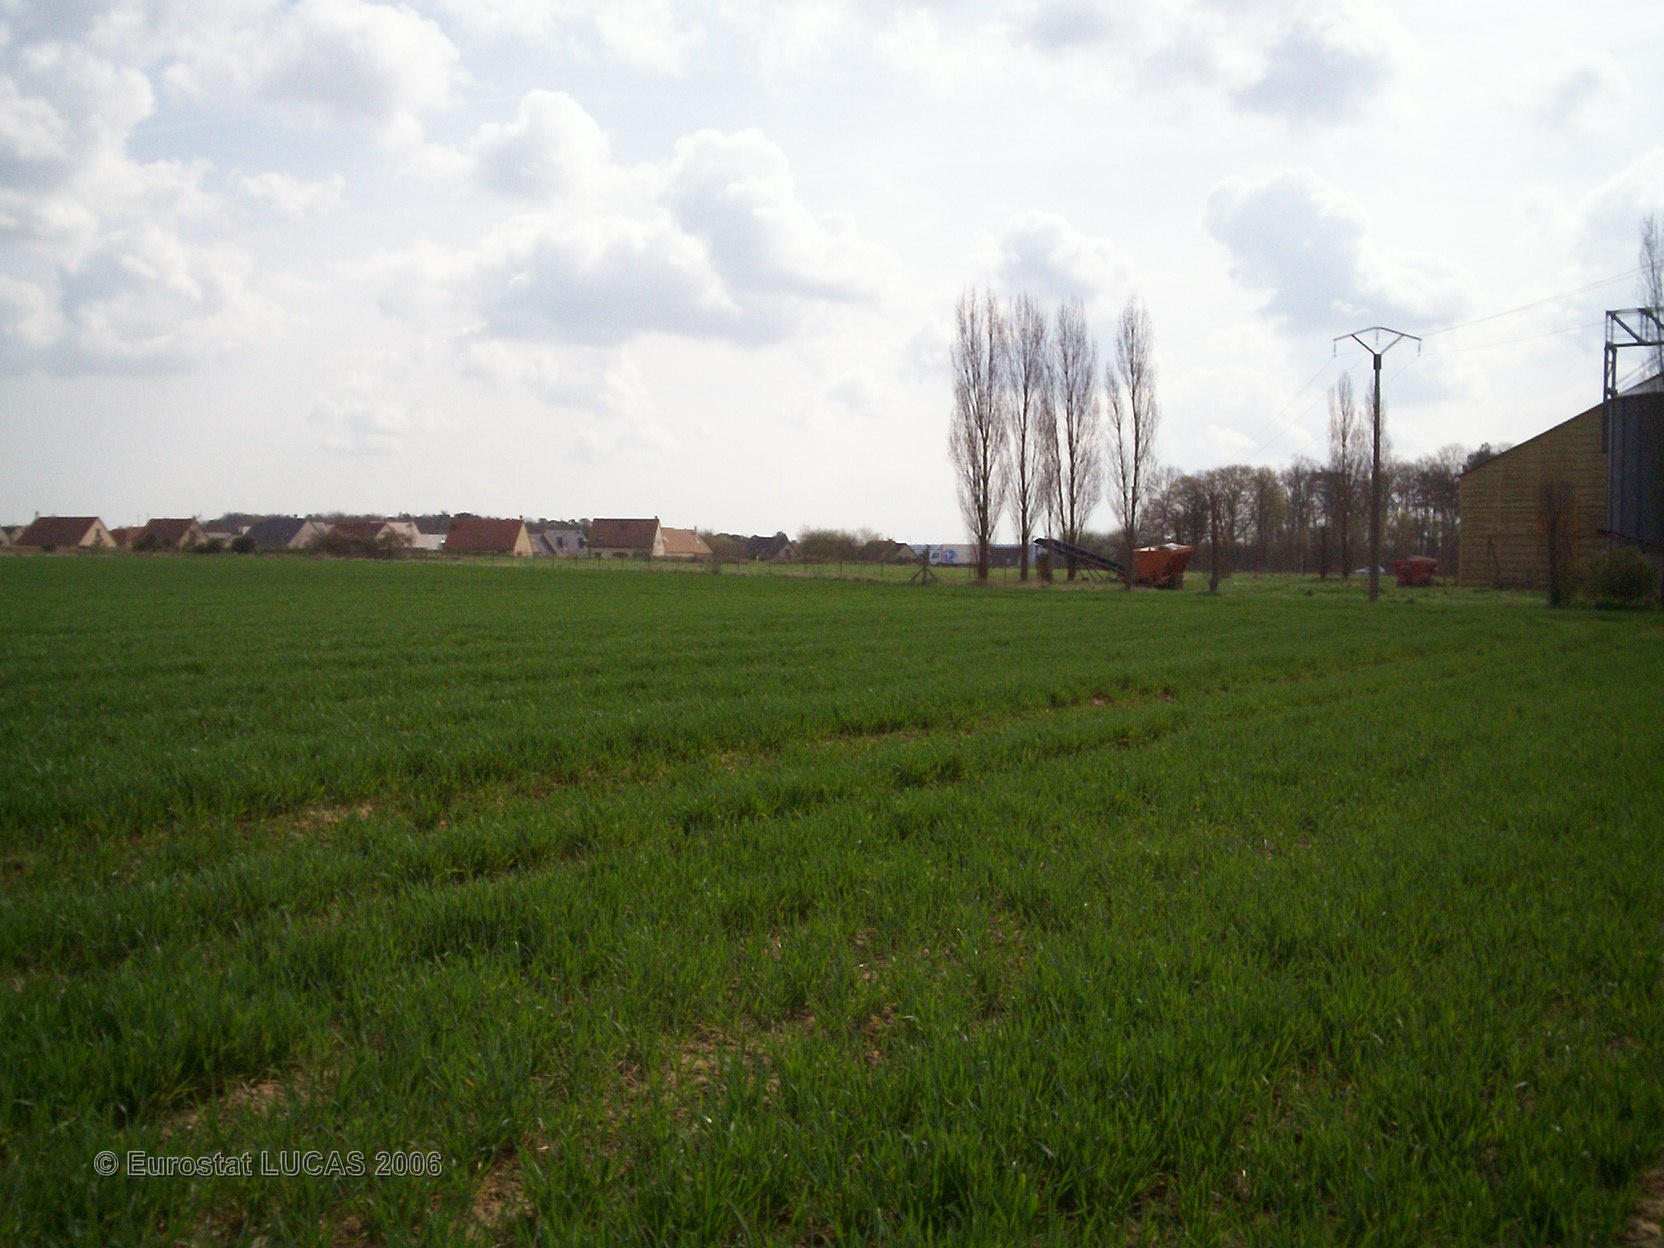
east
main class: Cropland
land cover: Common wheat
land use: Agriculture (excluding fallow land and kitchen gardens)
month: April
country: FR
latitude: 48.9973
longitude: 1.0260
